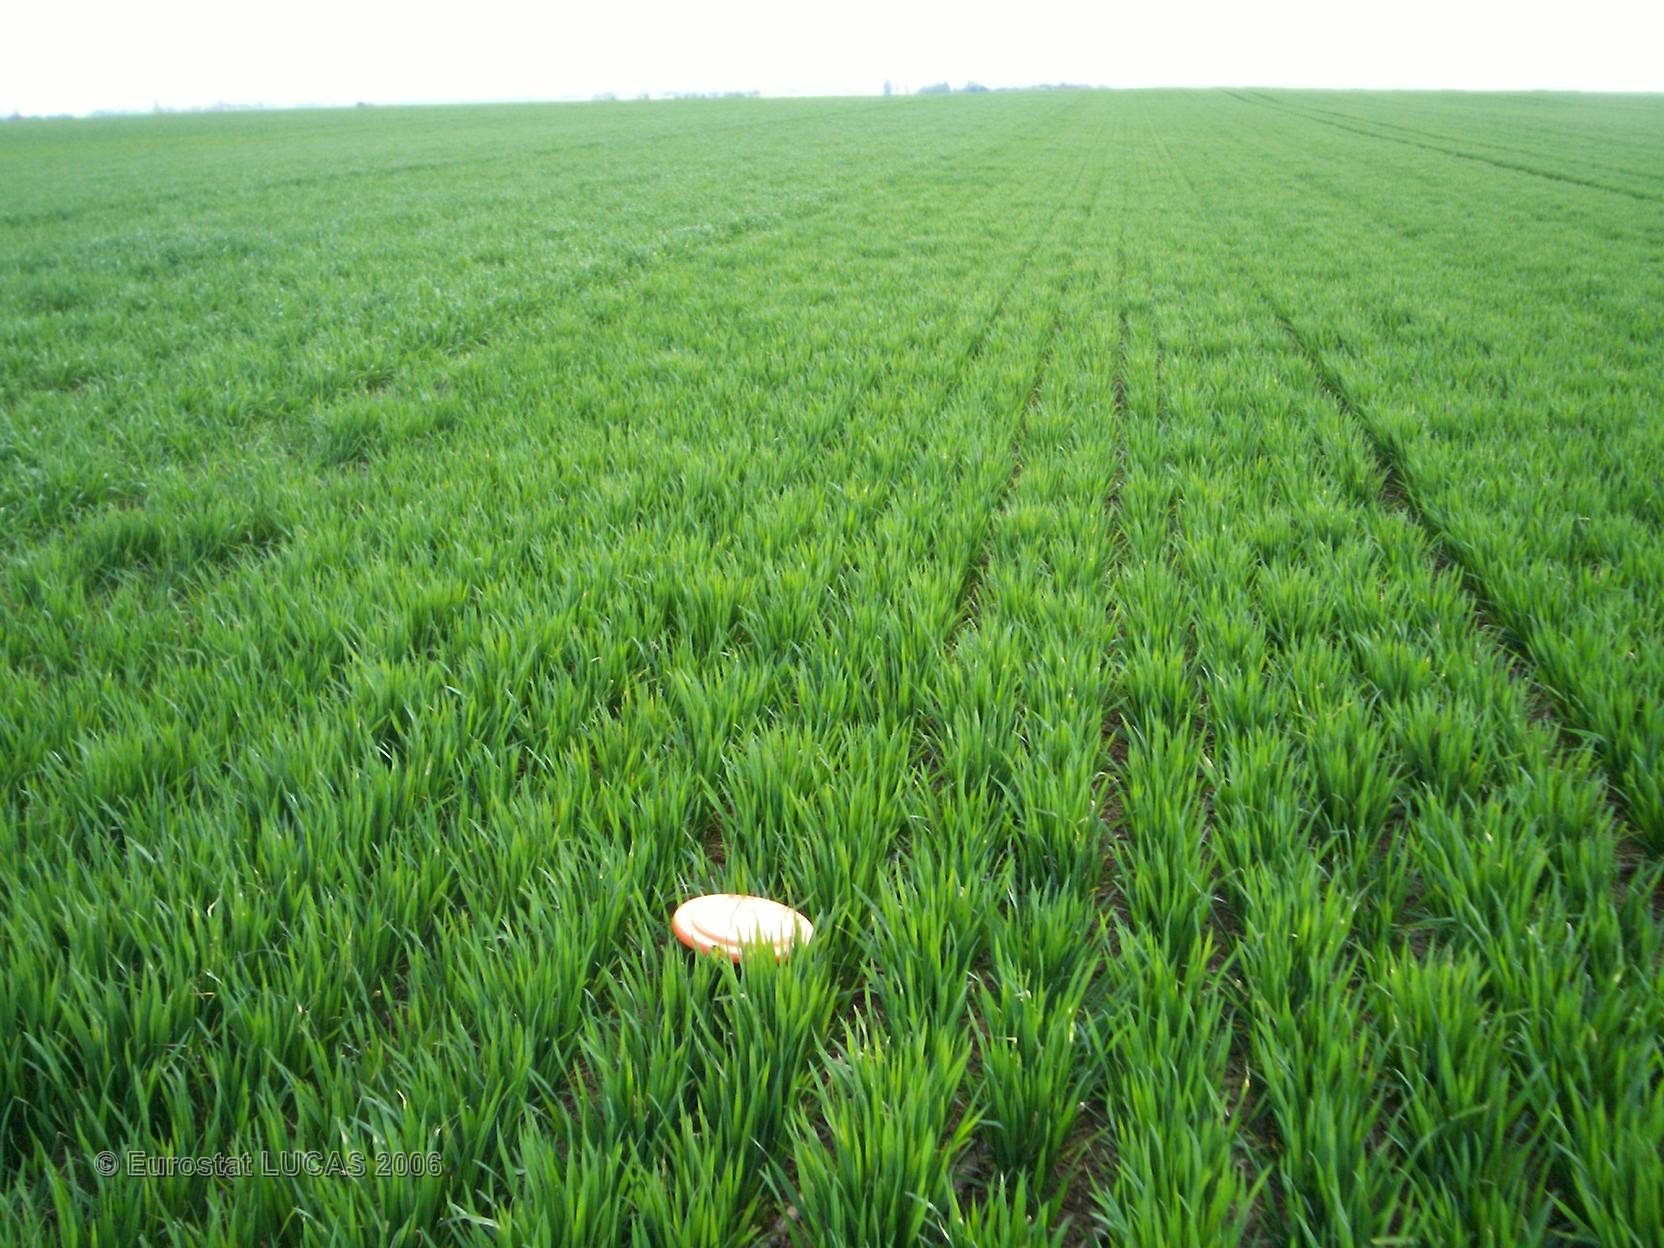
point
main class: Cropland
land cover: Common wheat
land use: Agriculture (excluding fallow land and kitchen gardens)
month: April
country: FR
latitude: 47.1958
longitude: 0.9151
